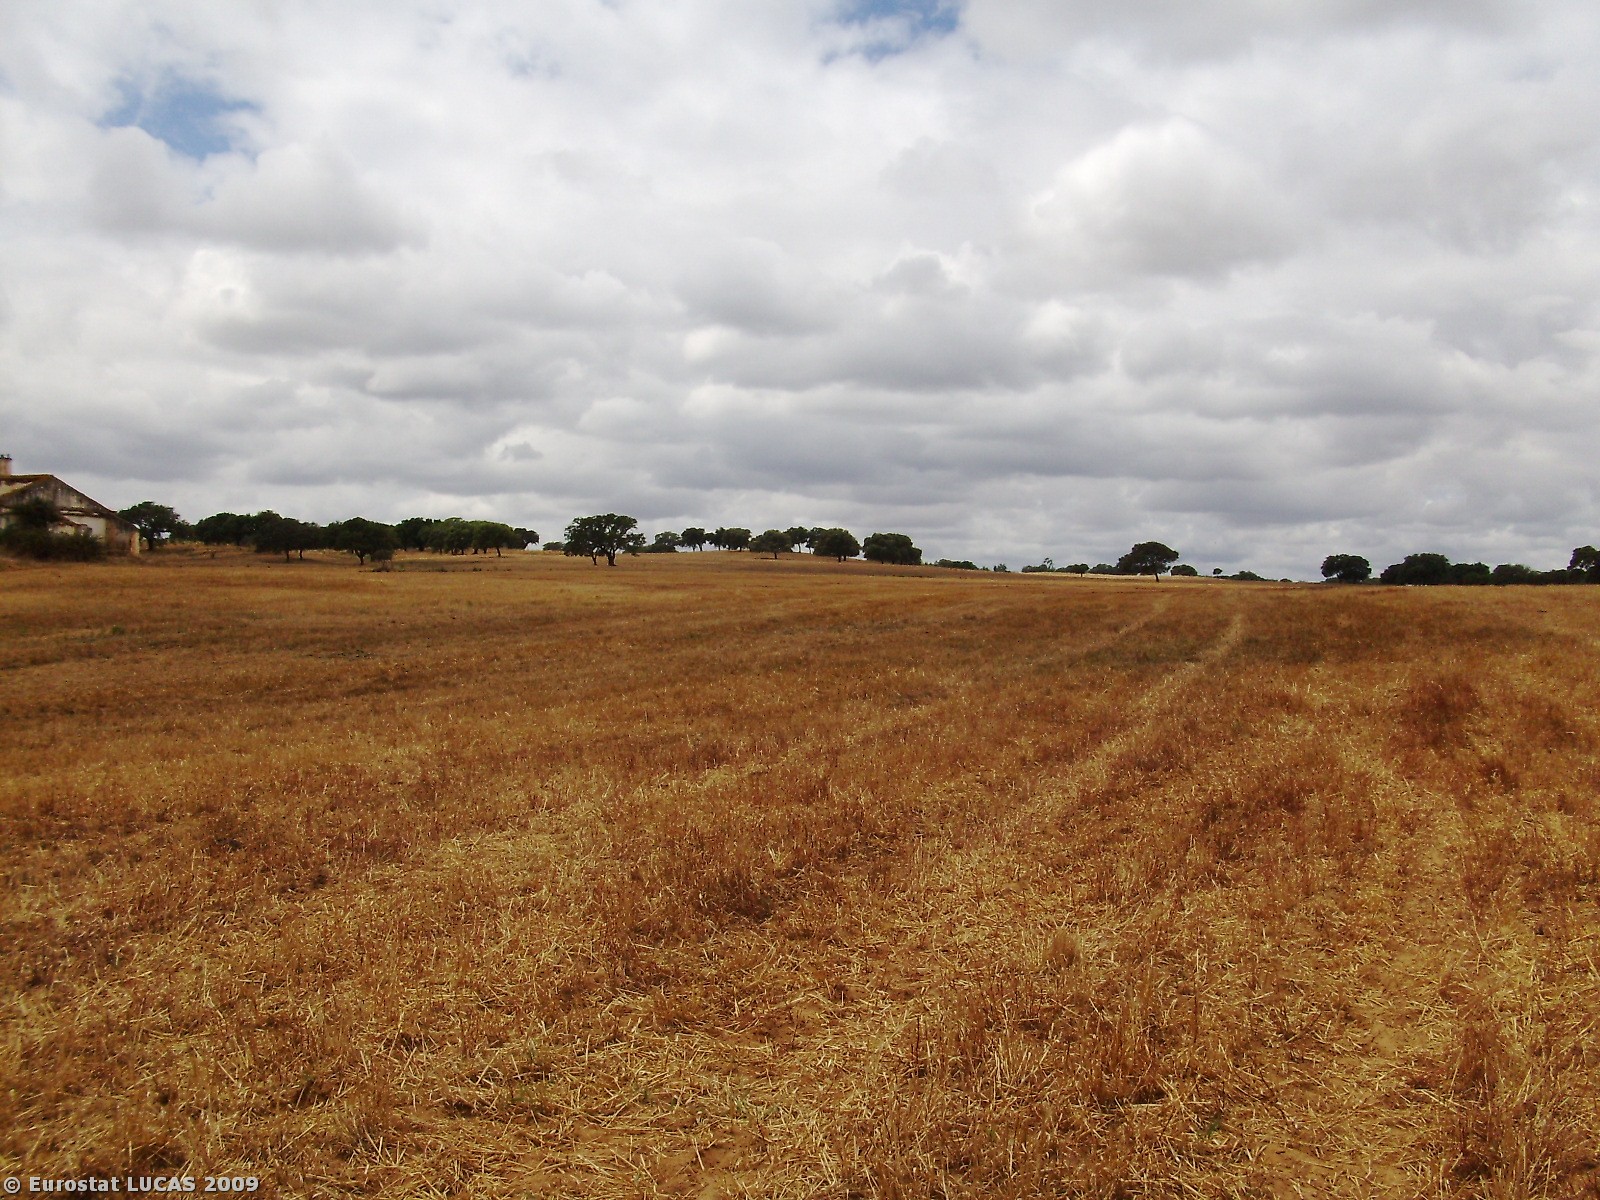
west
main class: Cropland
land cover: Oats
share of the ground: > 75 %
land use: Agriculture (excluding fallow land and kitchen gardens)
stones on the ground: < 10 %
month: June
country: PT
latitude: 37.8721
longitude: -8.4441
